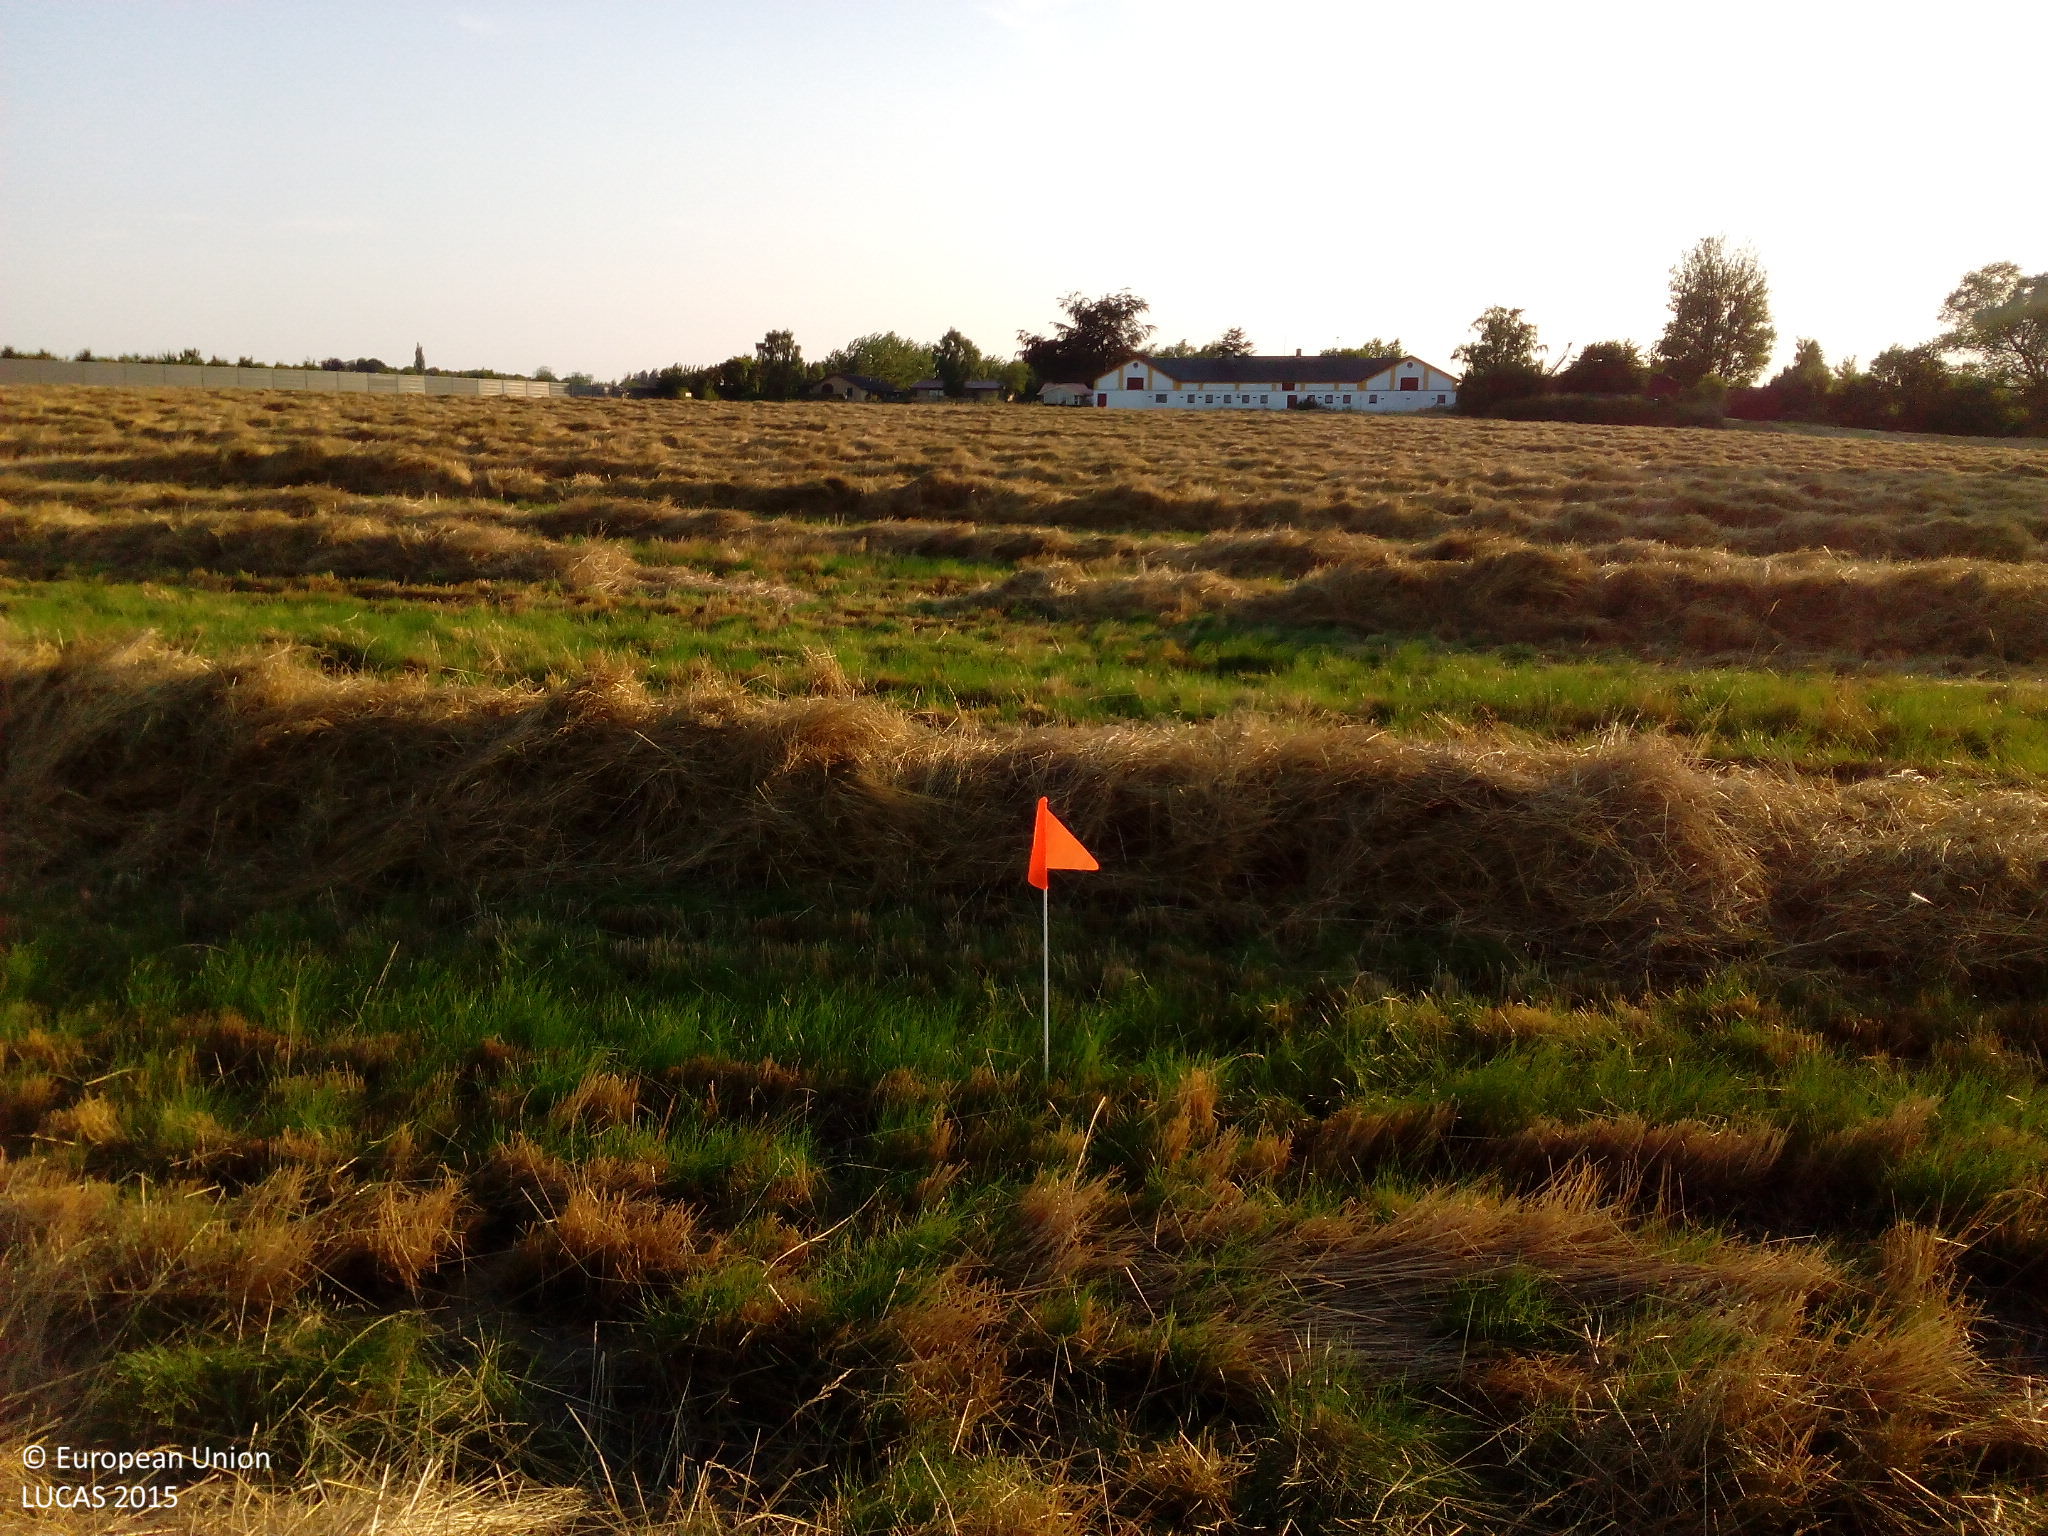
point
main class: Cropland
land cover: Temporary grasslands
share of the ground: > 75 %
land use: Agriculture (excluding fallow land and kitchen gardens)
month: August
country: DK
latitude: 55.6524
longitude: 11.8895
